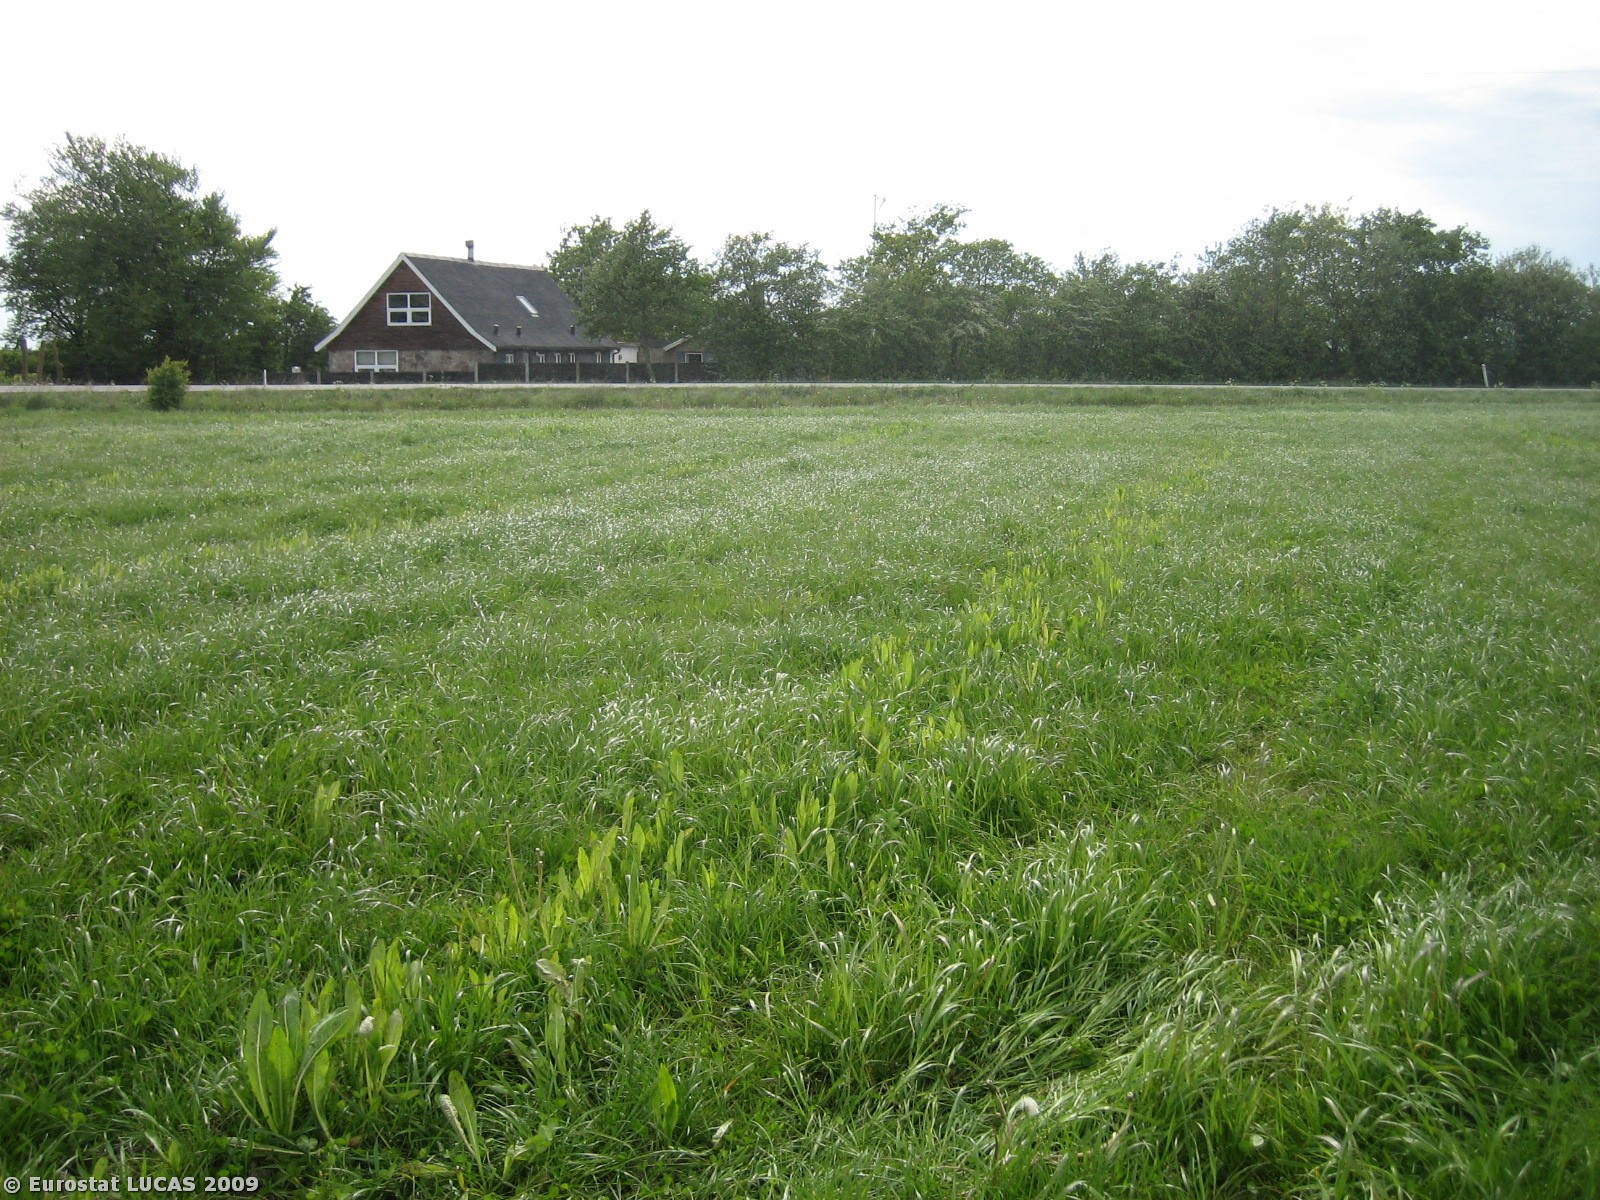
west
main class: Grassland
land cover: Grassland without tree/shrub cover
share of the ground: > 75 %
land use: Agriculture (excluding fallow land and kitchen gardens)
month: May
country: DK
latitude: 56.0341
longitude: 8.4128
